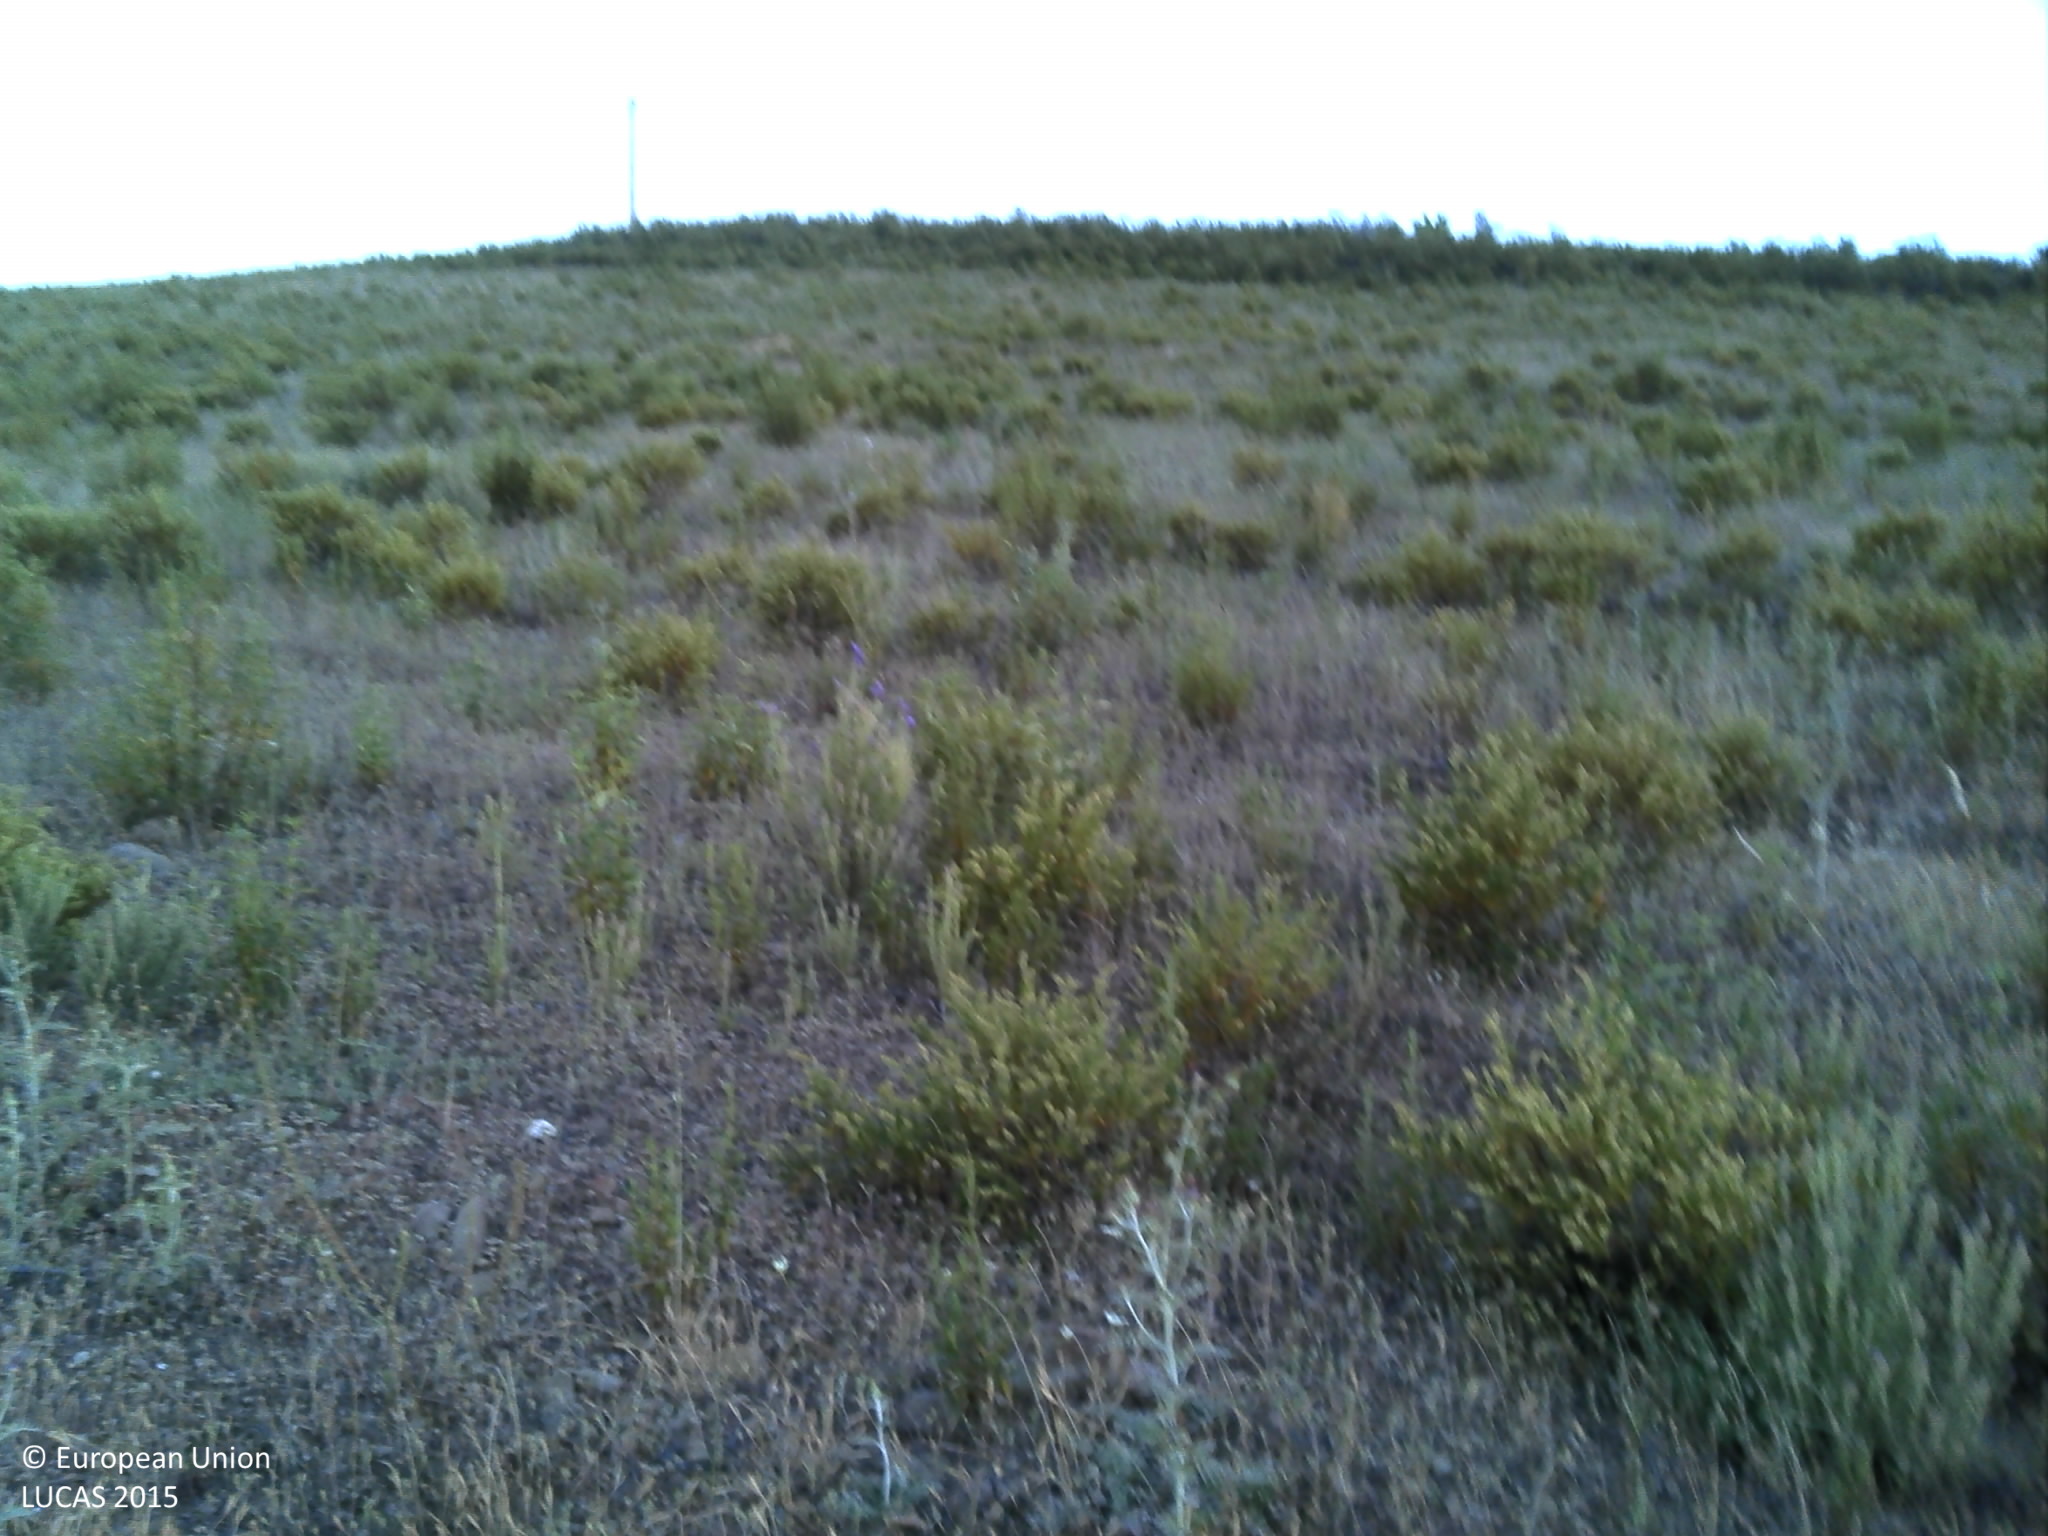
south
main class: Shrubland
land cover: Shrubland without tree cover
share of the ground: 10 - 25 %
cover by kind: herbaceous plants 65 %, shrubs 25 %, unconsolidated bare surface 10 %
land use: Abandoned areas
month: May
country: PT
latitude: 37.4356
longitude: -7.5379
